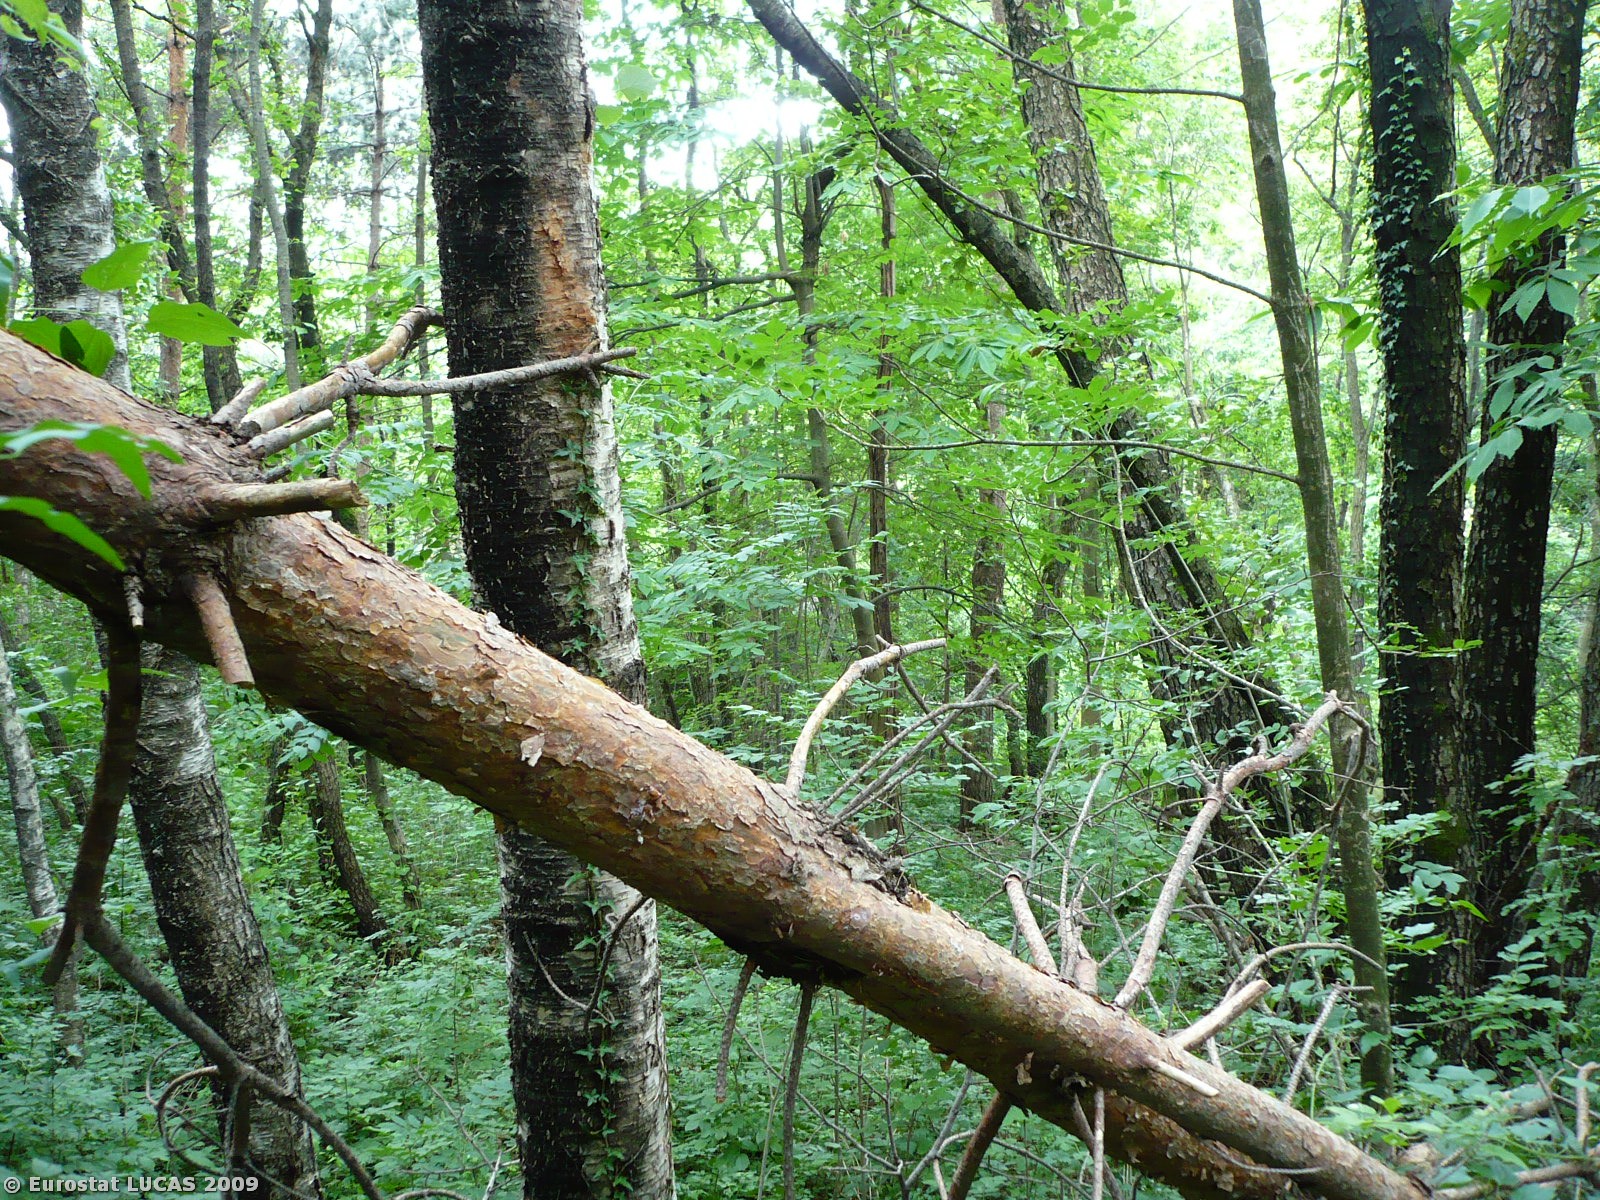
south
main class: Woodland
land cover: Broadleaved woodland
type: thermophilous deciduous forest
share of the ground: > 75 %
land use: Unused
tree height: > 5 m
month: June
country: SI
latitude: 46.0364
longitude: 13.6529
